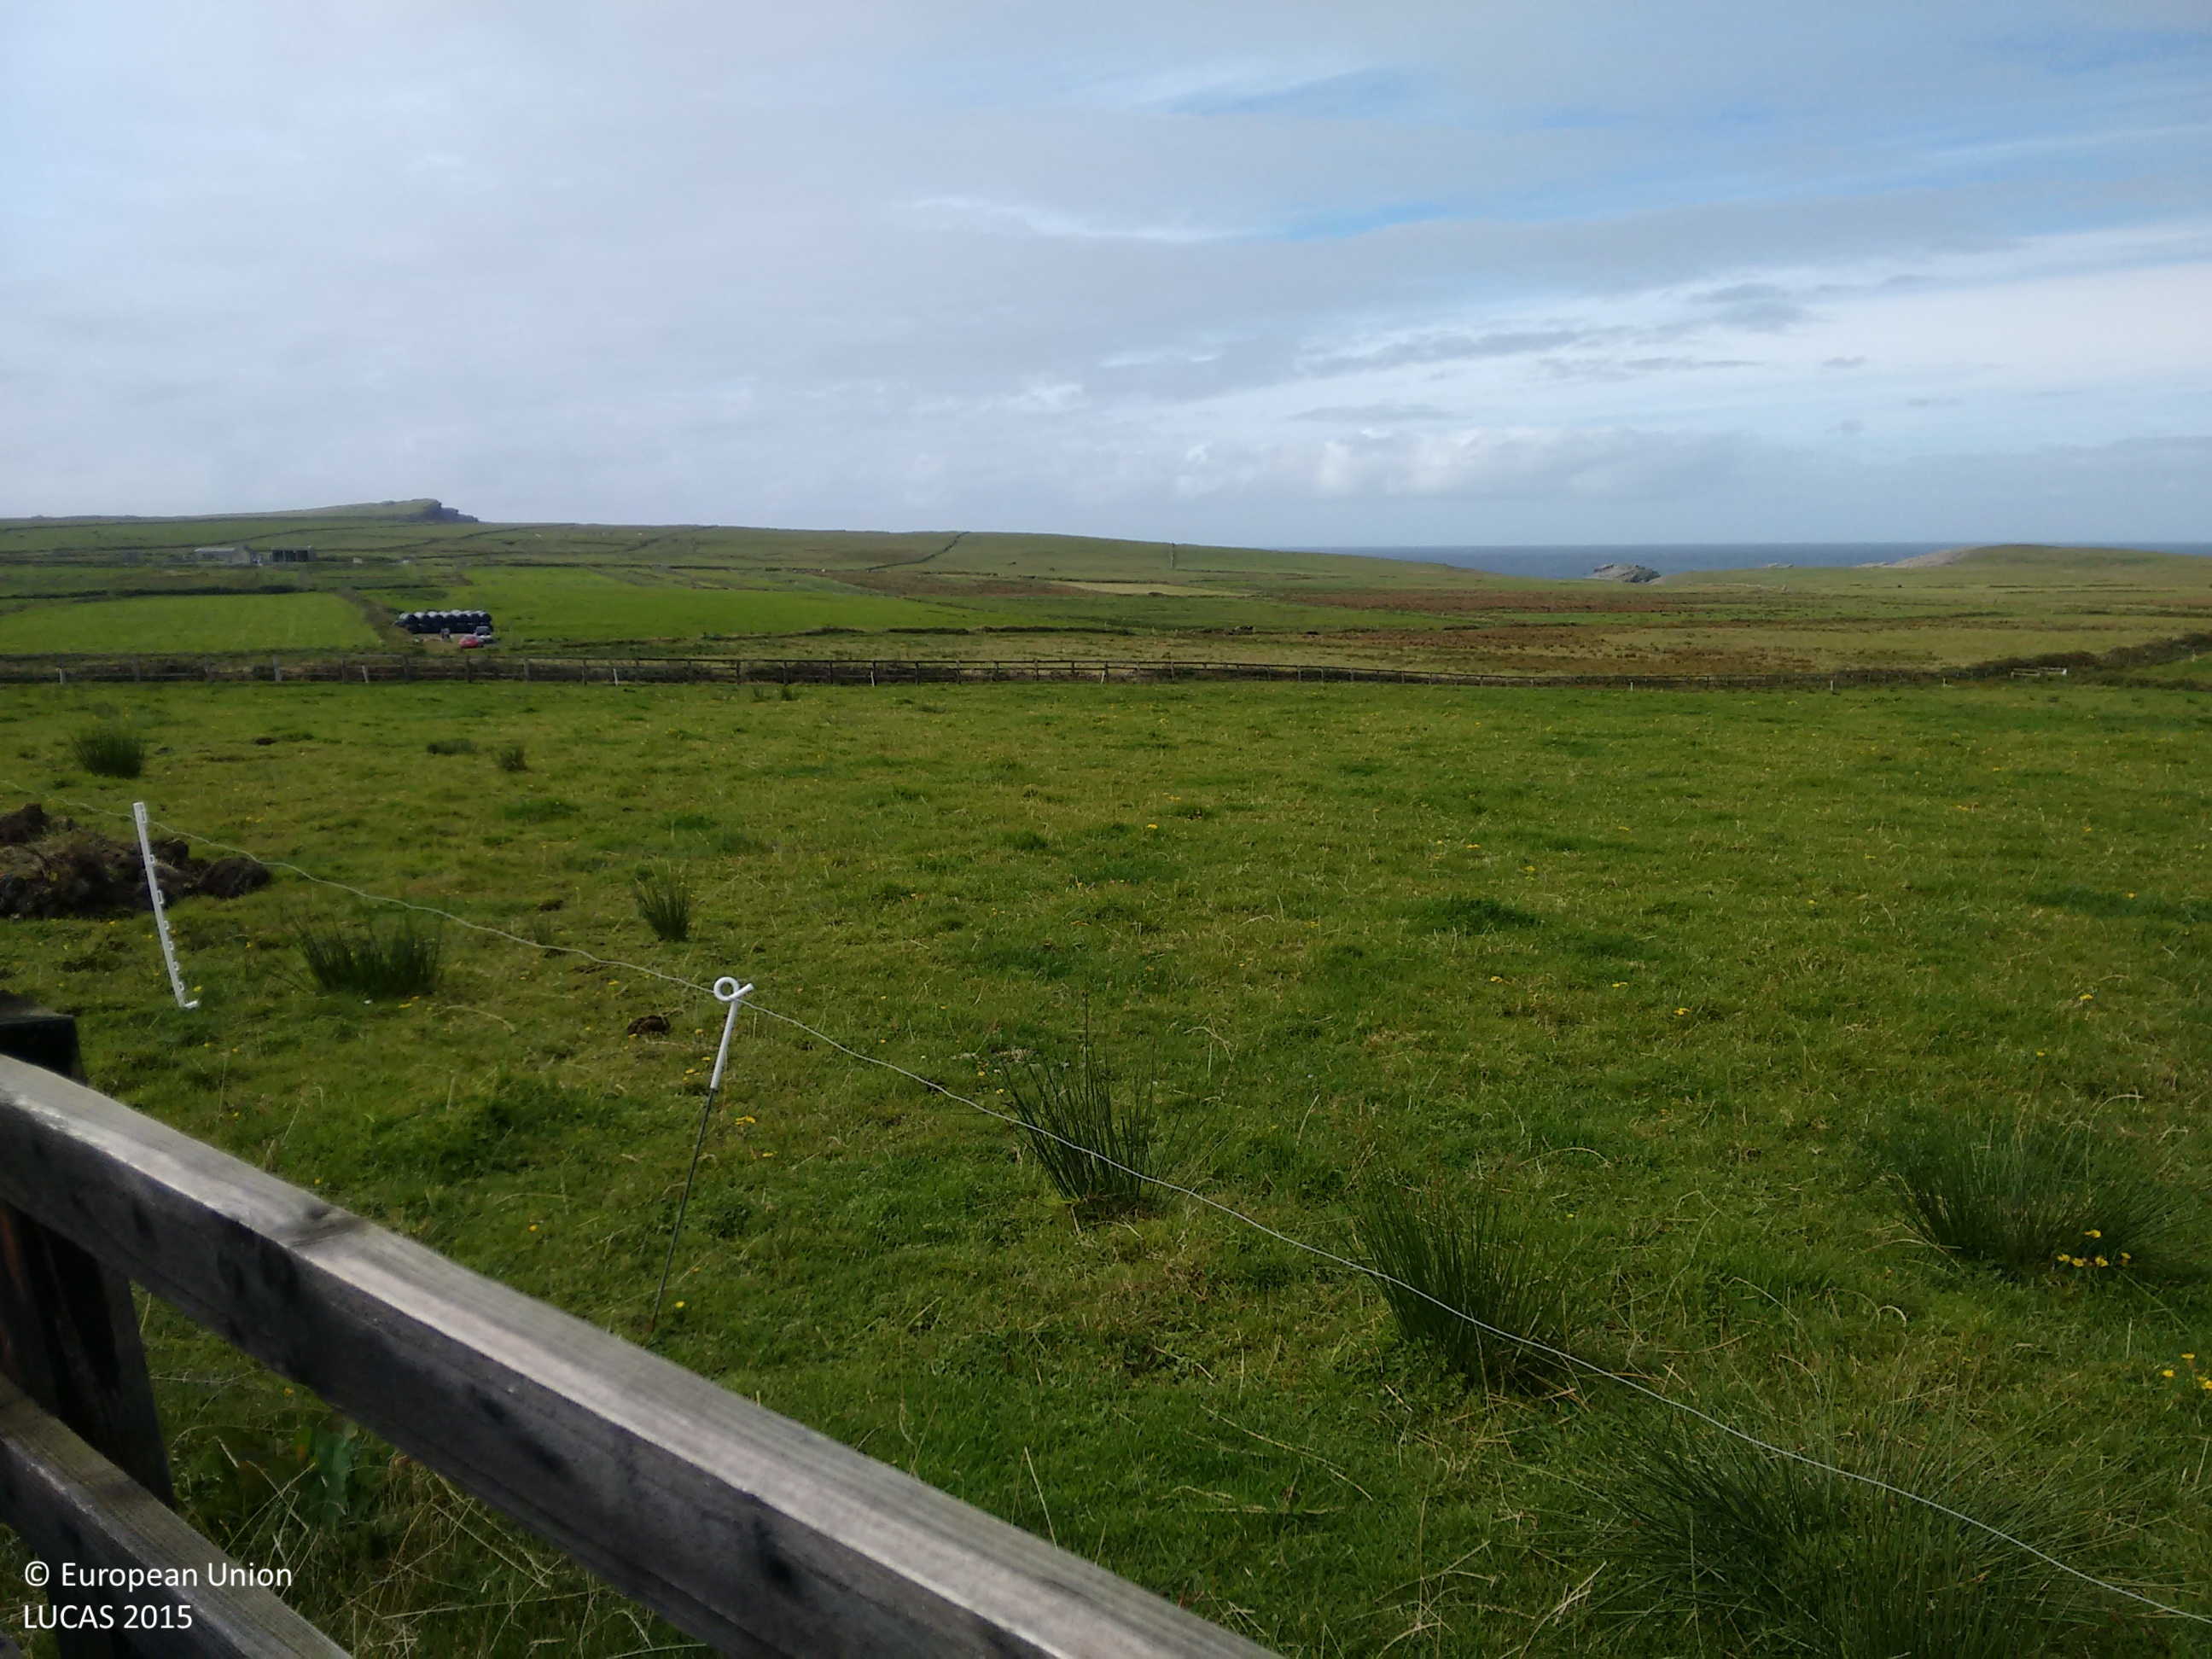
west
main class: Grassland
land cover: Grassland without tree/shrub cover
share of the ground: > 75 %
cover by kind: herbaceous plants 100 %
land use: Agriculture (excluding fallow land and kitchen gardens)
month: September
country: IE
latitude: 52.7406
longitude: -9.5962
